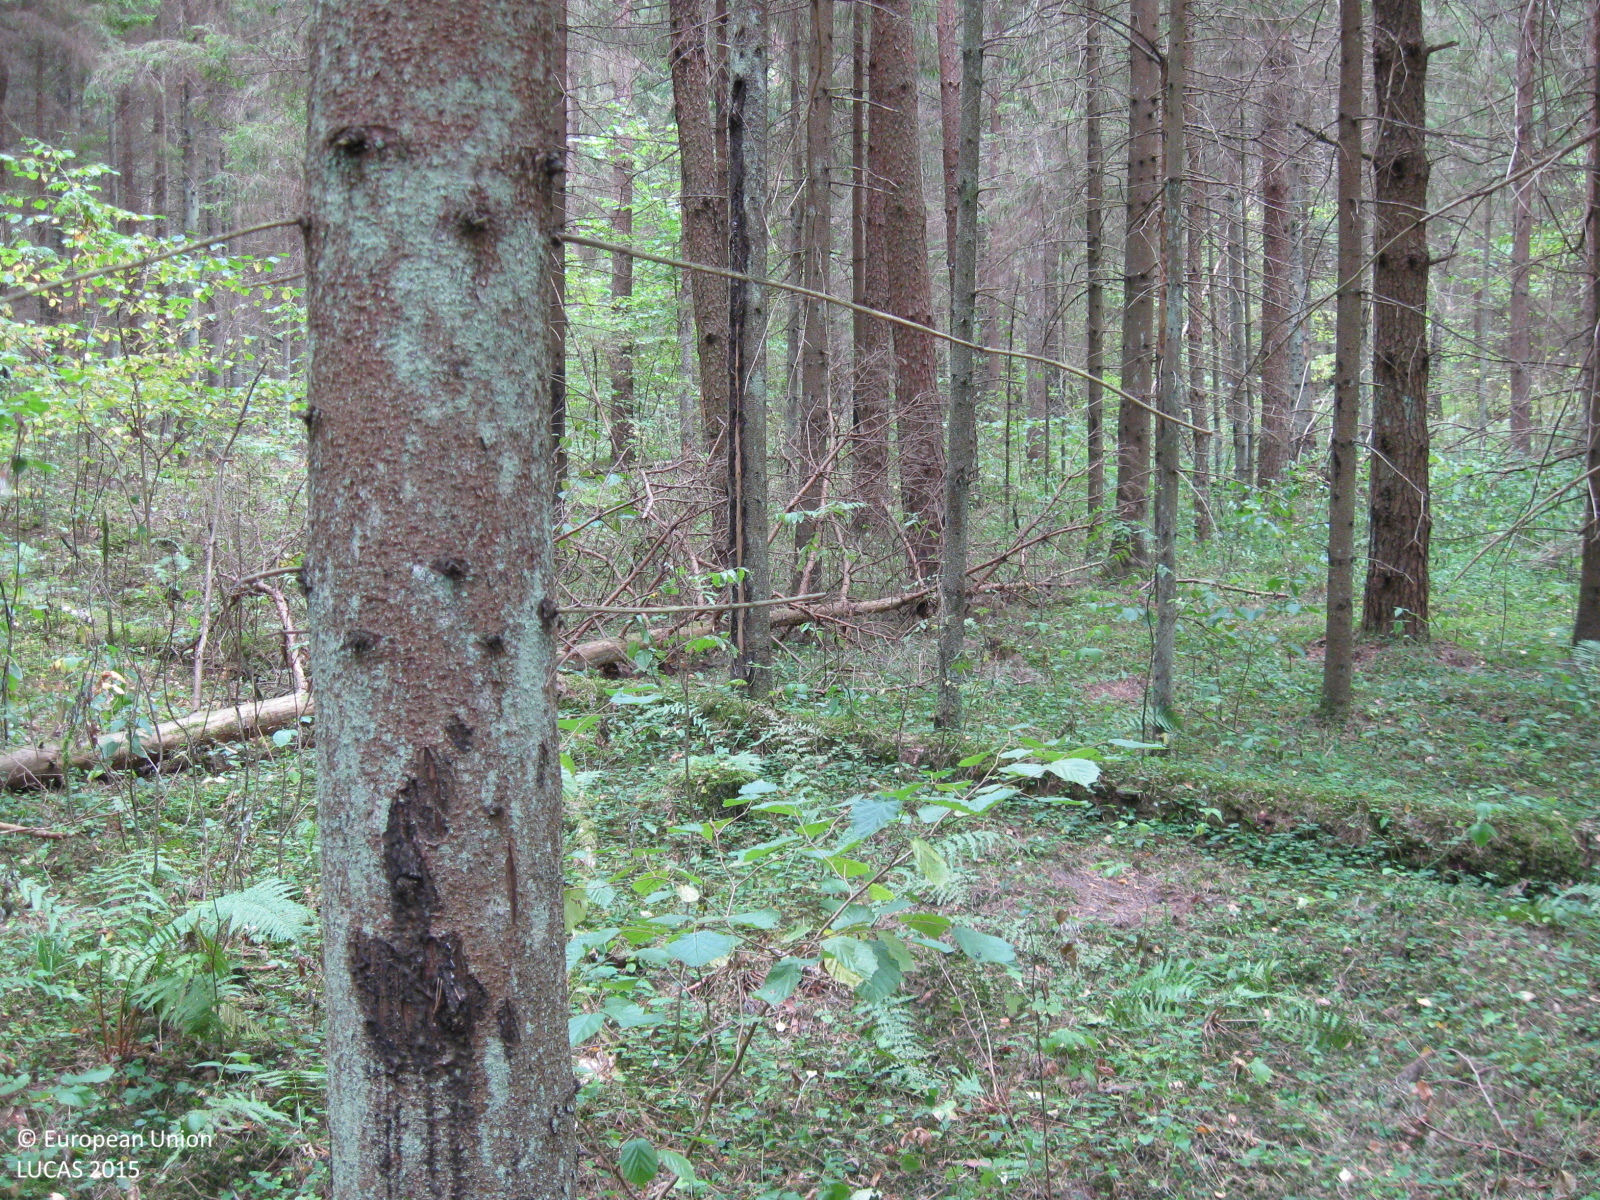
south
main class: Woodland
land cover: Pine dominated coniferous woodland
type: hemiboreal forest and nemoral coniferous forest and mixed broadleaved-coniferous forest
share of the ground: > 75 %
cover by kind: coniferous forest trees 85 %, broadleaved forest trees 5 %, herbaceous plants 5 %, lichens and mosses 5 %
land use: Forestry
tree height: > 5 m
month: August
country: LT
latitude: 55.6123
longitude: 23.3642
